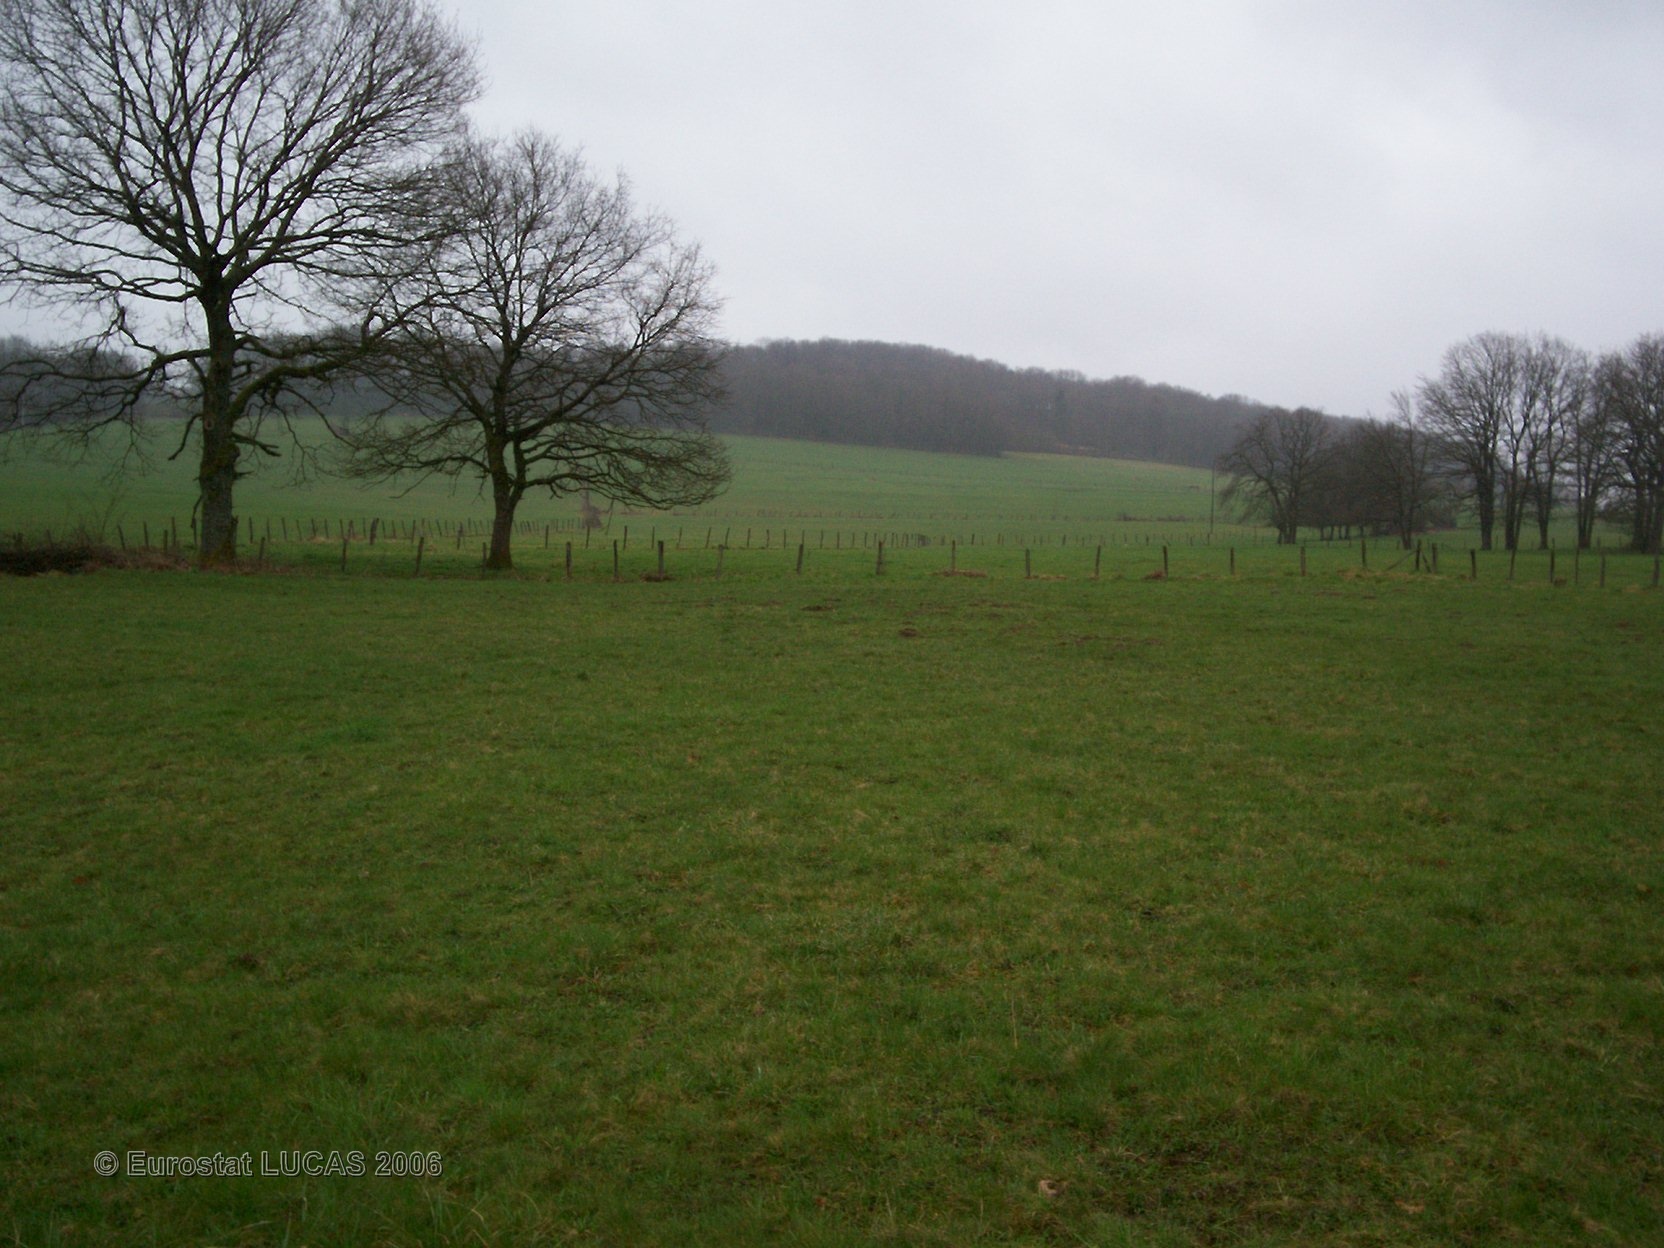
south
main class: Grassland
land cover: Grassland without tree/shrub cover
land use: Agriculture (excluding fallow land and kitchen gardens)
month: April
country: FR
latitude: 47.6186
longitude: 6.7950
